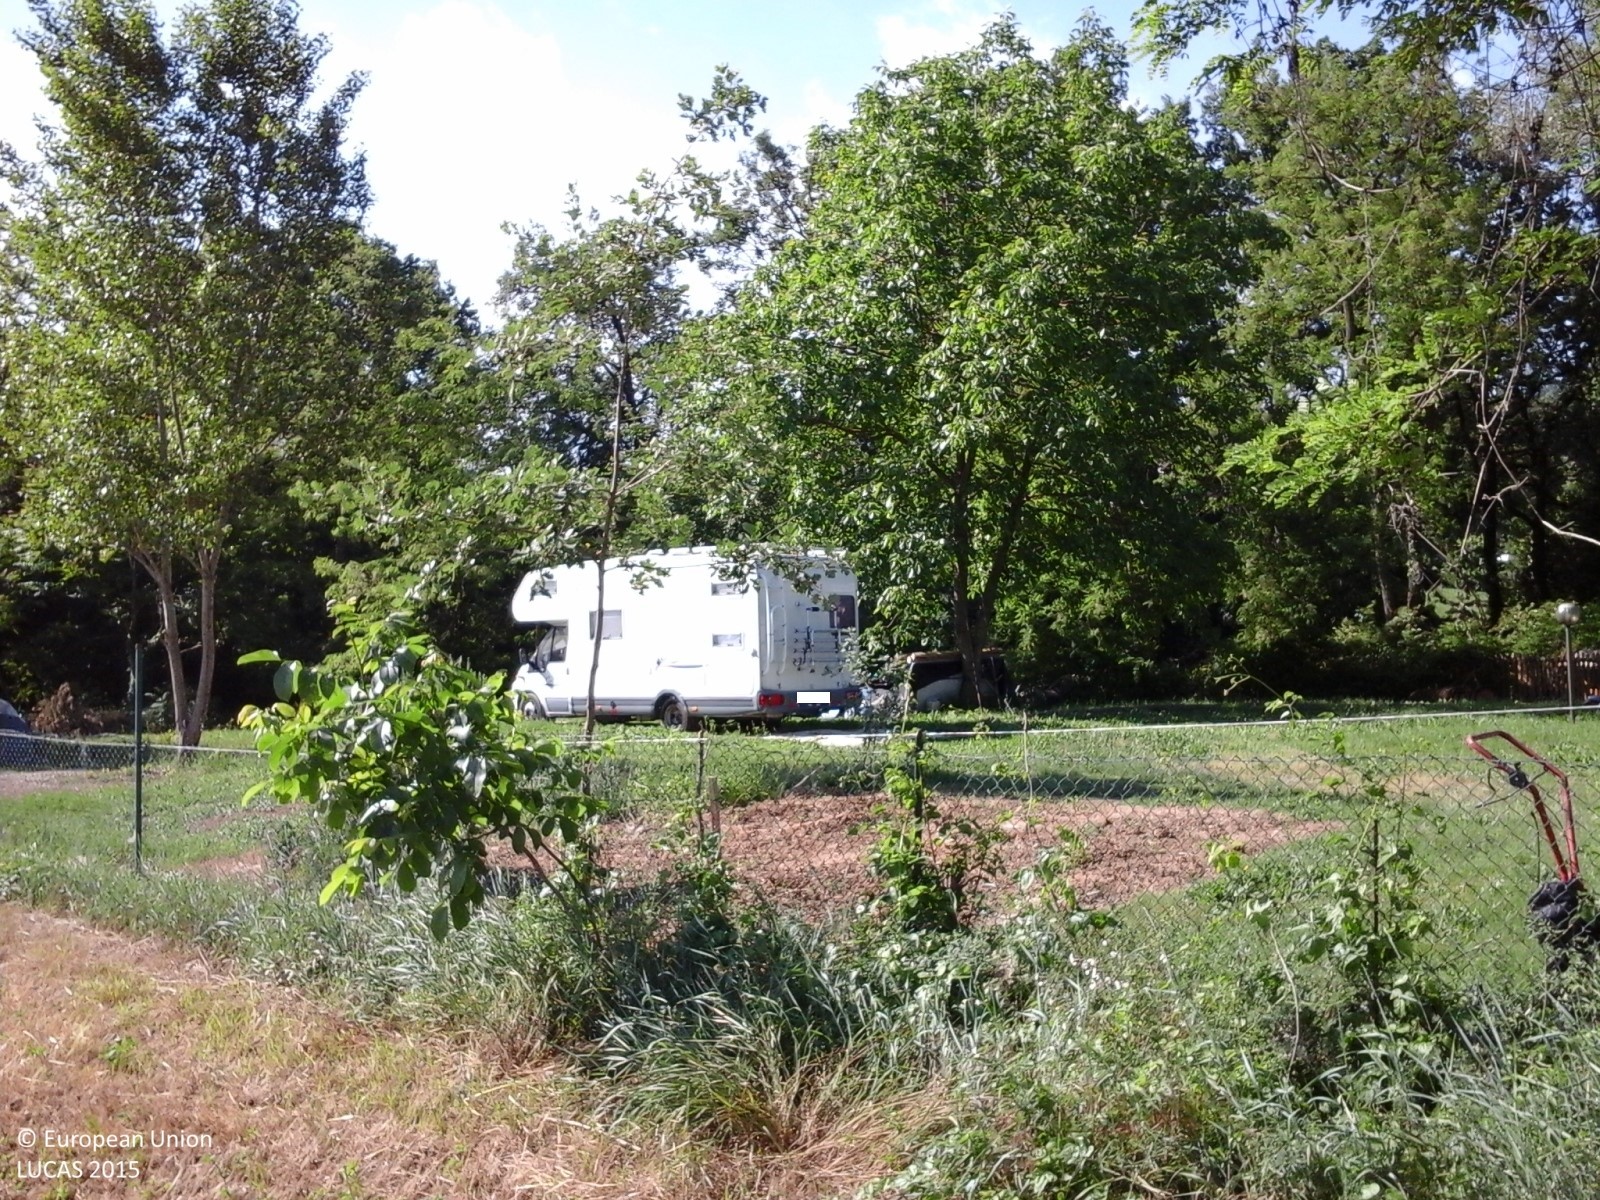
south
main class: Cropland
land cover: Lucerne
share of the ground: > 75 %
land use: Agriculture (excluding fallow land and kitchen gardens)
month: May
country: IT
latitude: 44.6011
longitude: 10.6411
